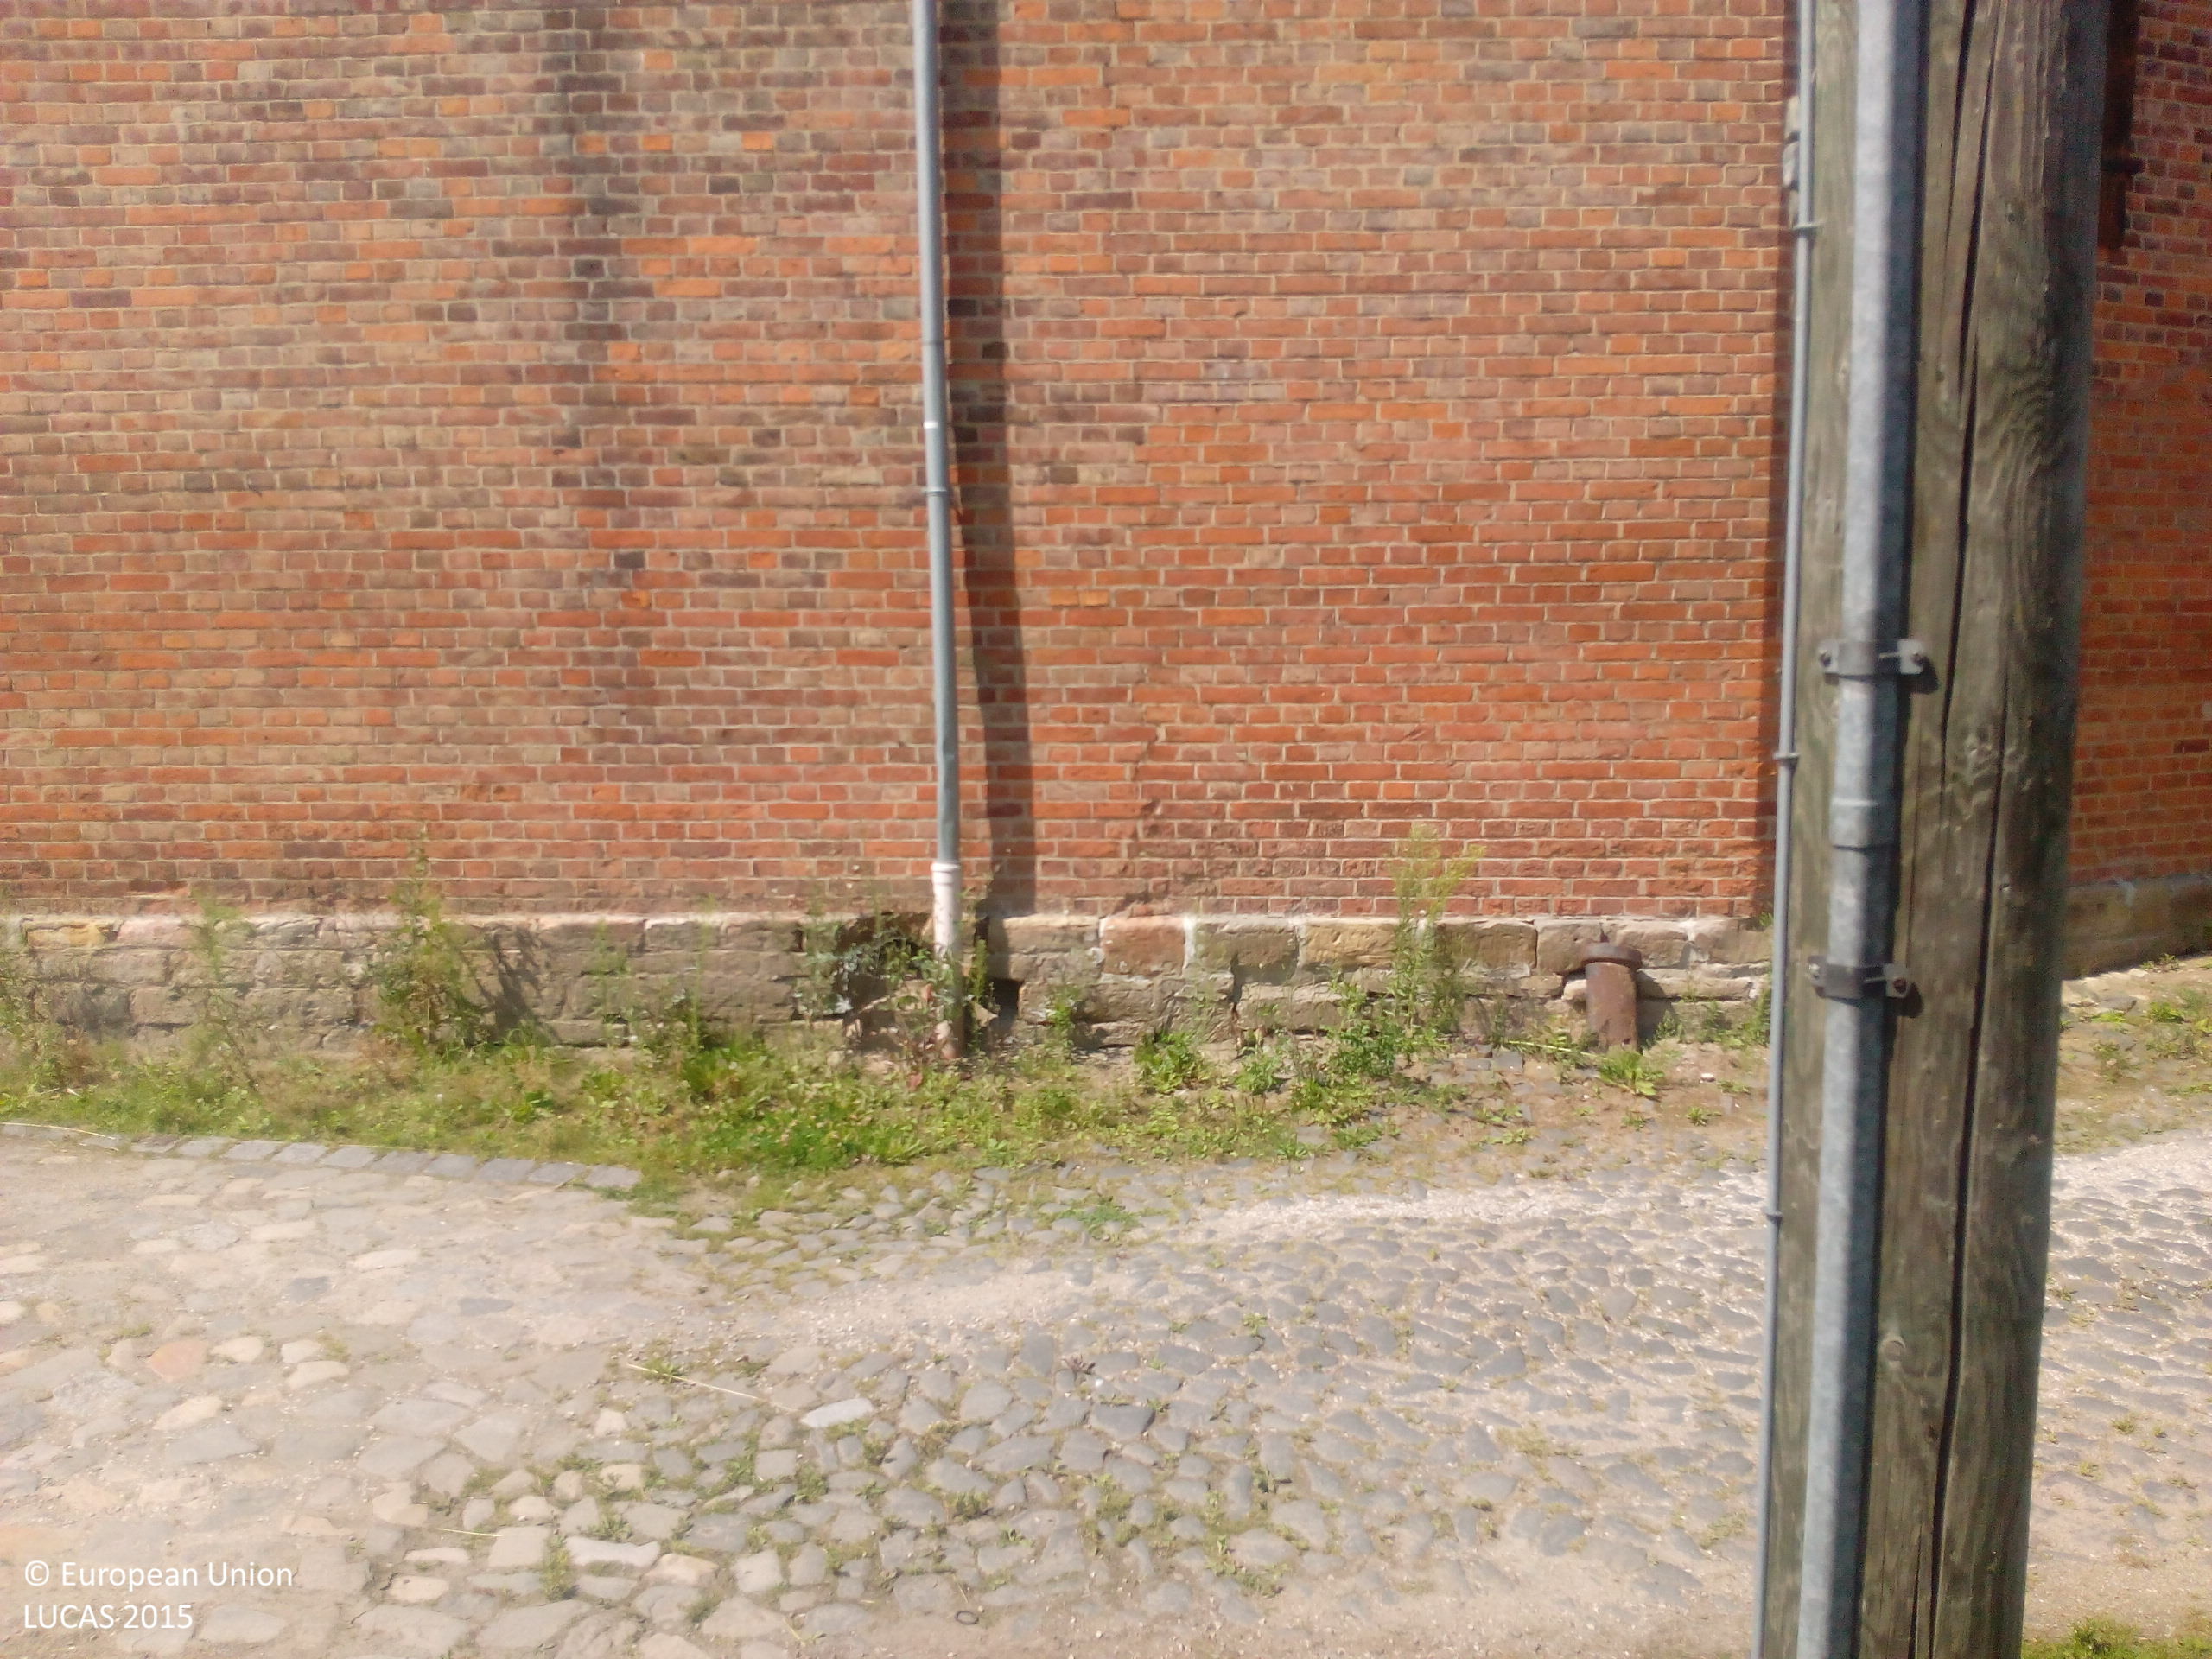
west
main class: Grassland
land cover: Grassland with sparse tree/shrub cover
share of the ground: > 75 %
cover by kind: herbaceous plants 95 %, broadleaved forest trees 5 %
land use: Residential
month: August
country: DE
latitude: 52.0845
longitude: 11.1233
